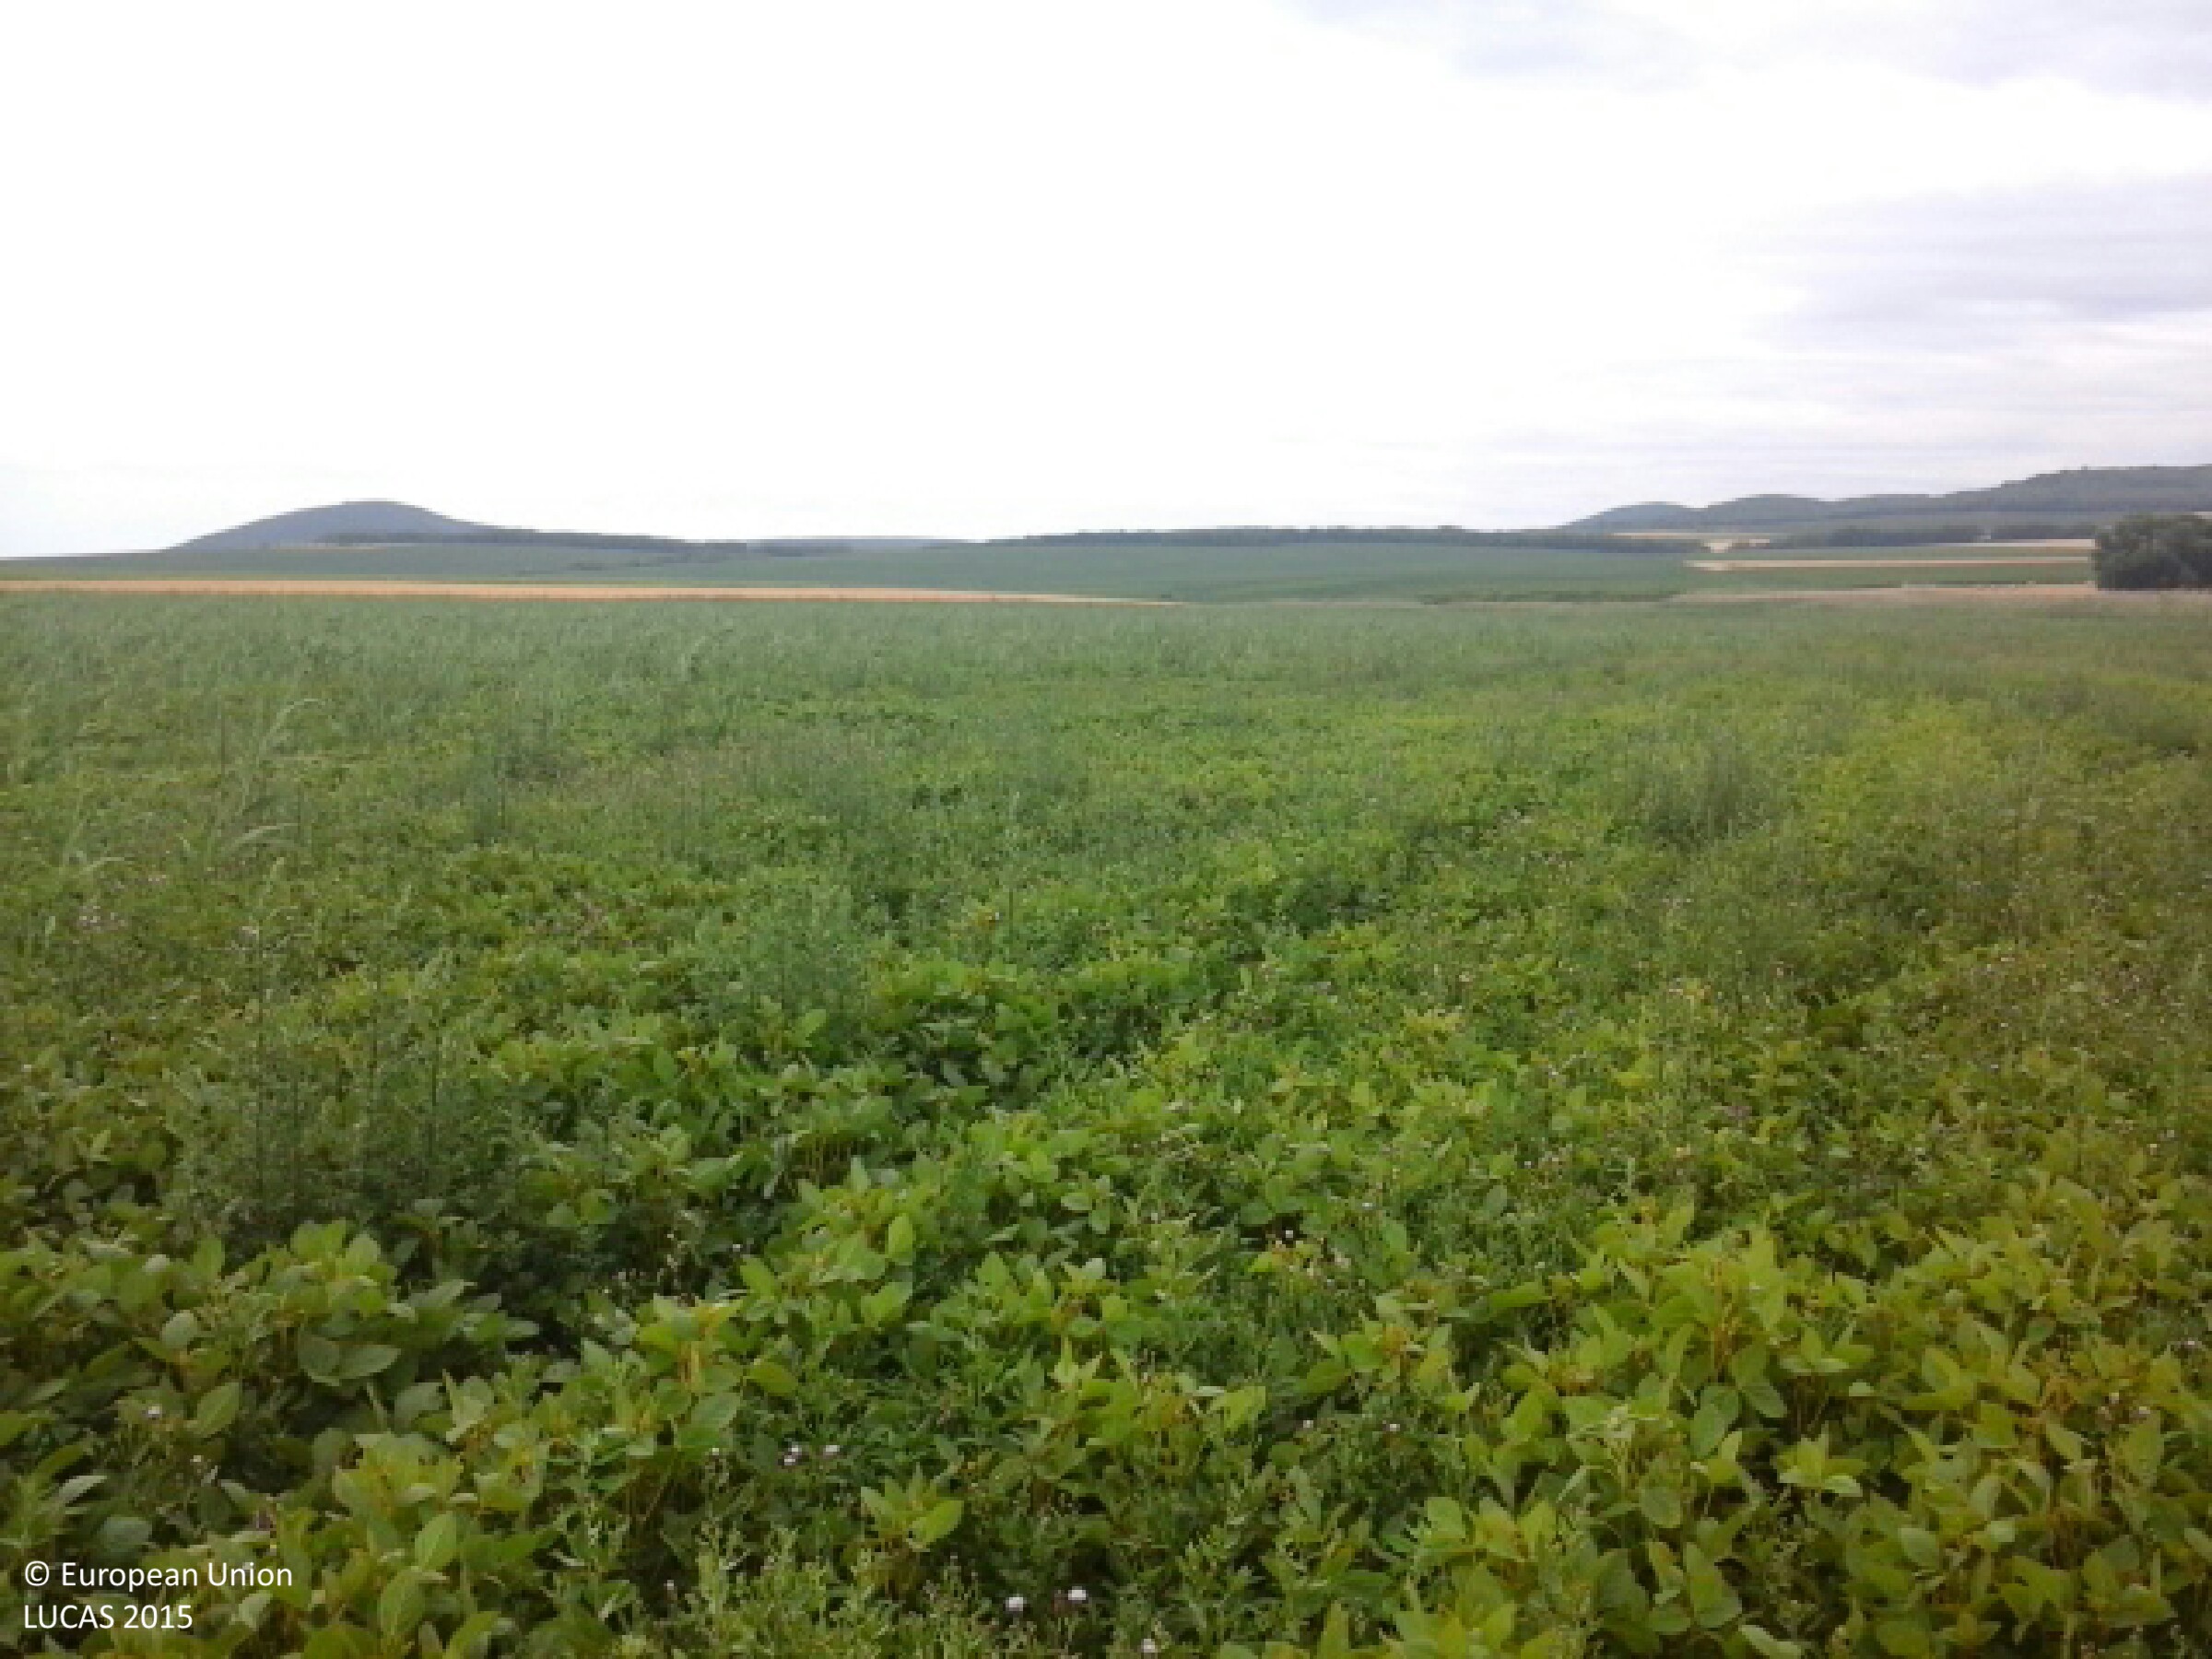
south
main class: Grassland
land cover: Spontaneously vegetated surfaces
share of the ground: > 75 %
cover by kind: herbaceous plants 100 %
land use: Abandoned areas
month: July
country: HU
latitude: 48.2550
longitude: 21.1536
